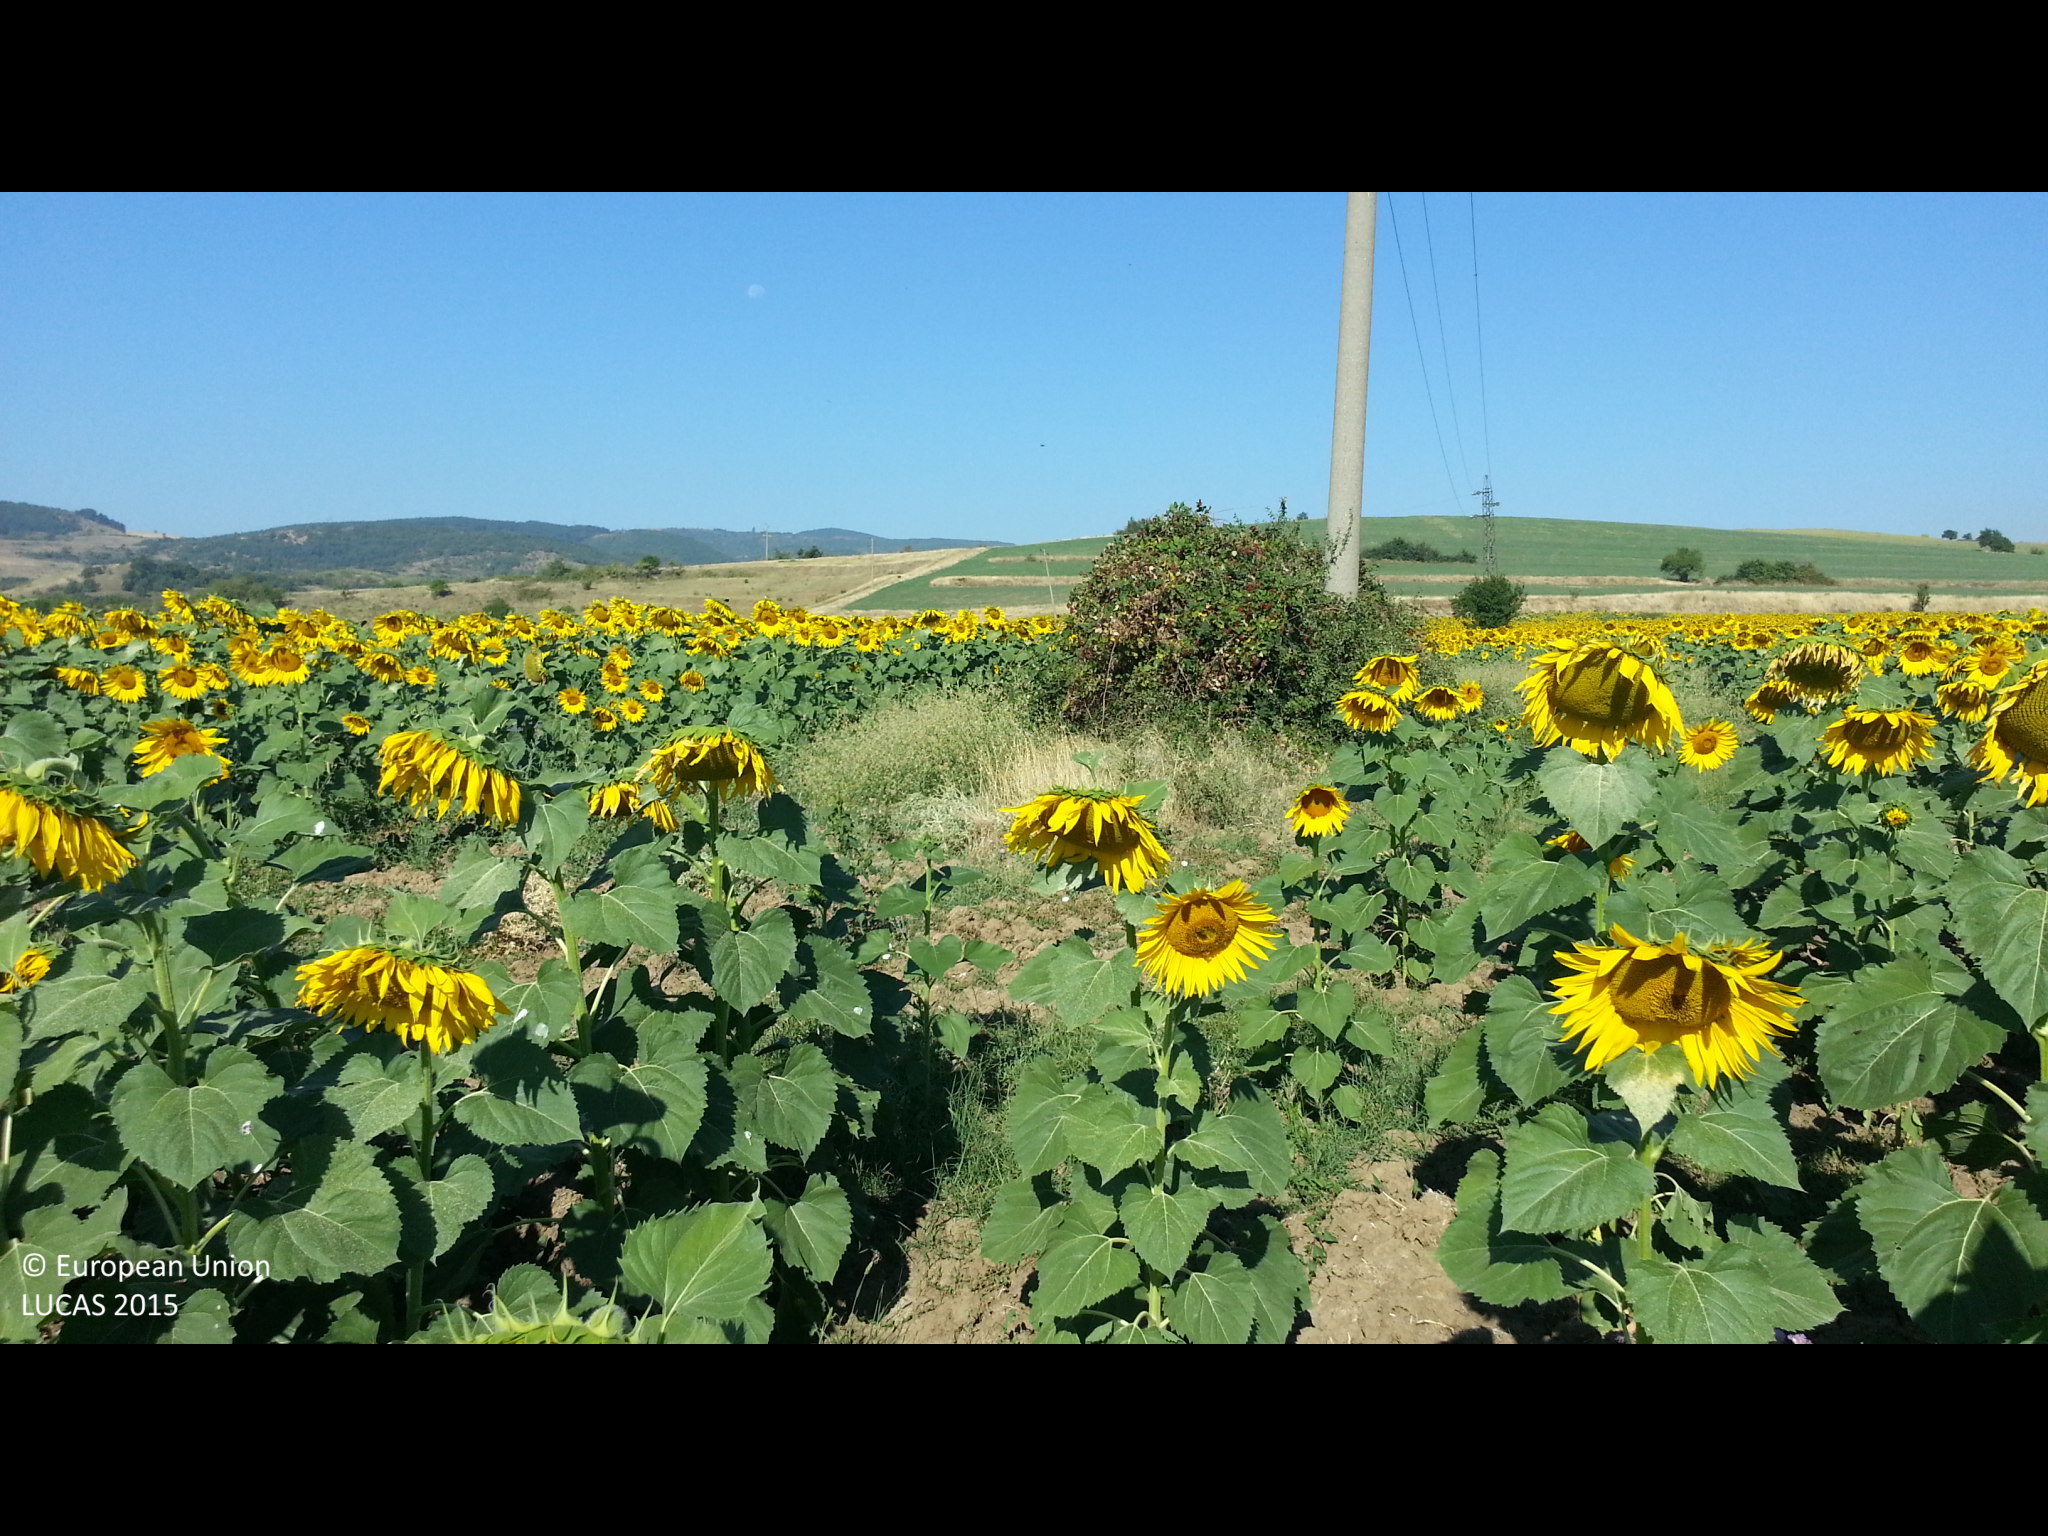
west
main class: Cropland
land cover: Sunflower
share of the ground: > 75 %
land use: Agriculture (excluding fallow land and kitchen gardens)
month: September
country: BG
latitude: 42.2082
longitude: 23.0463
